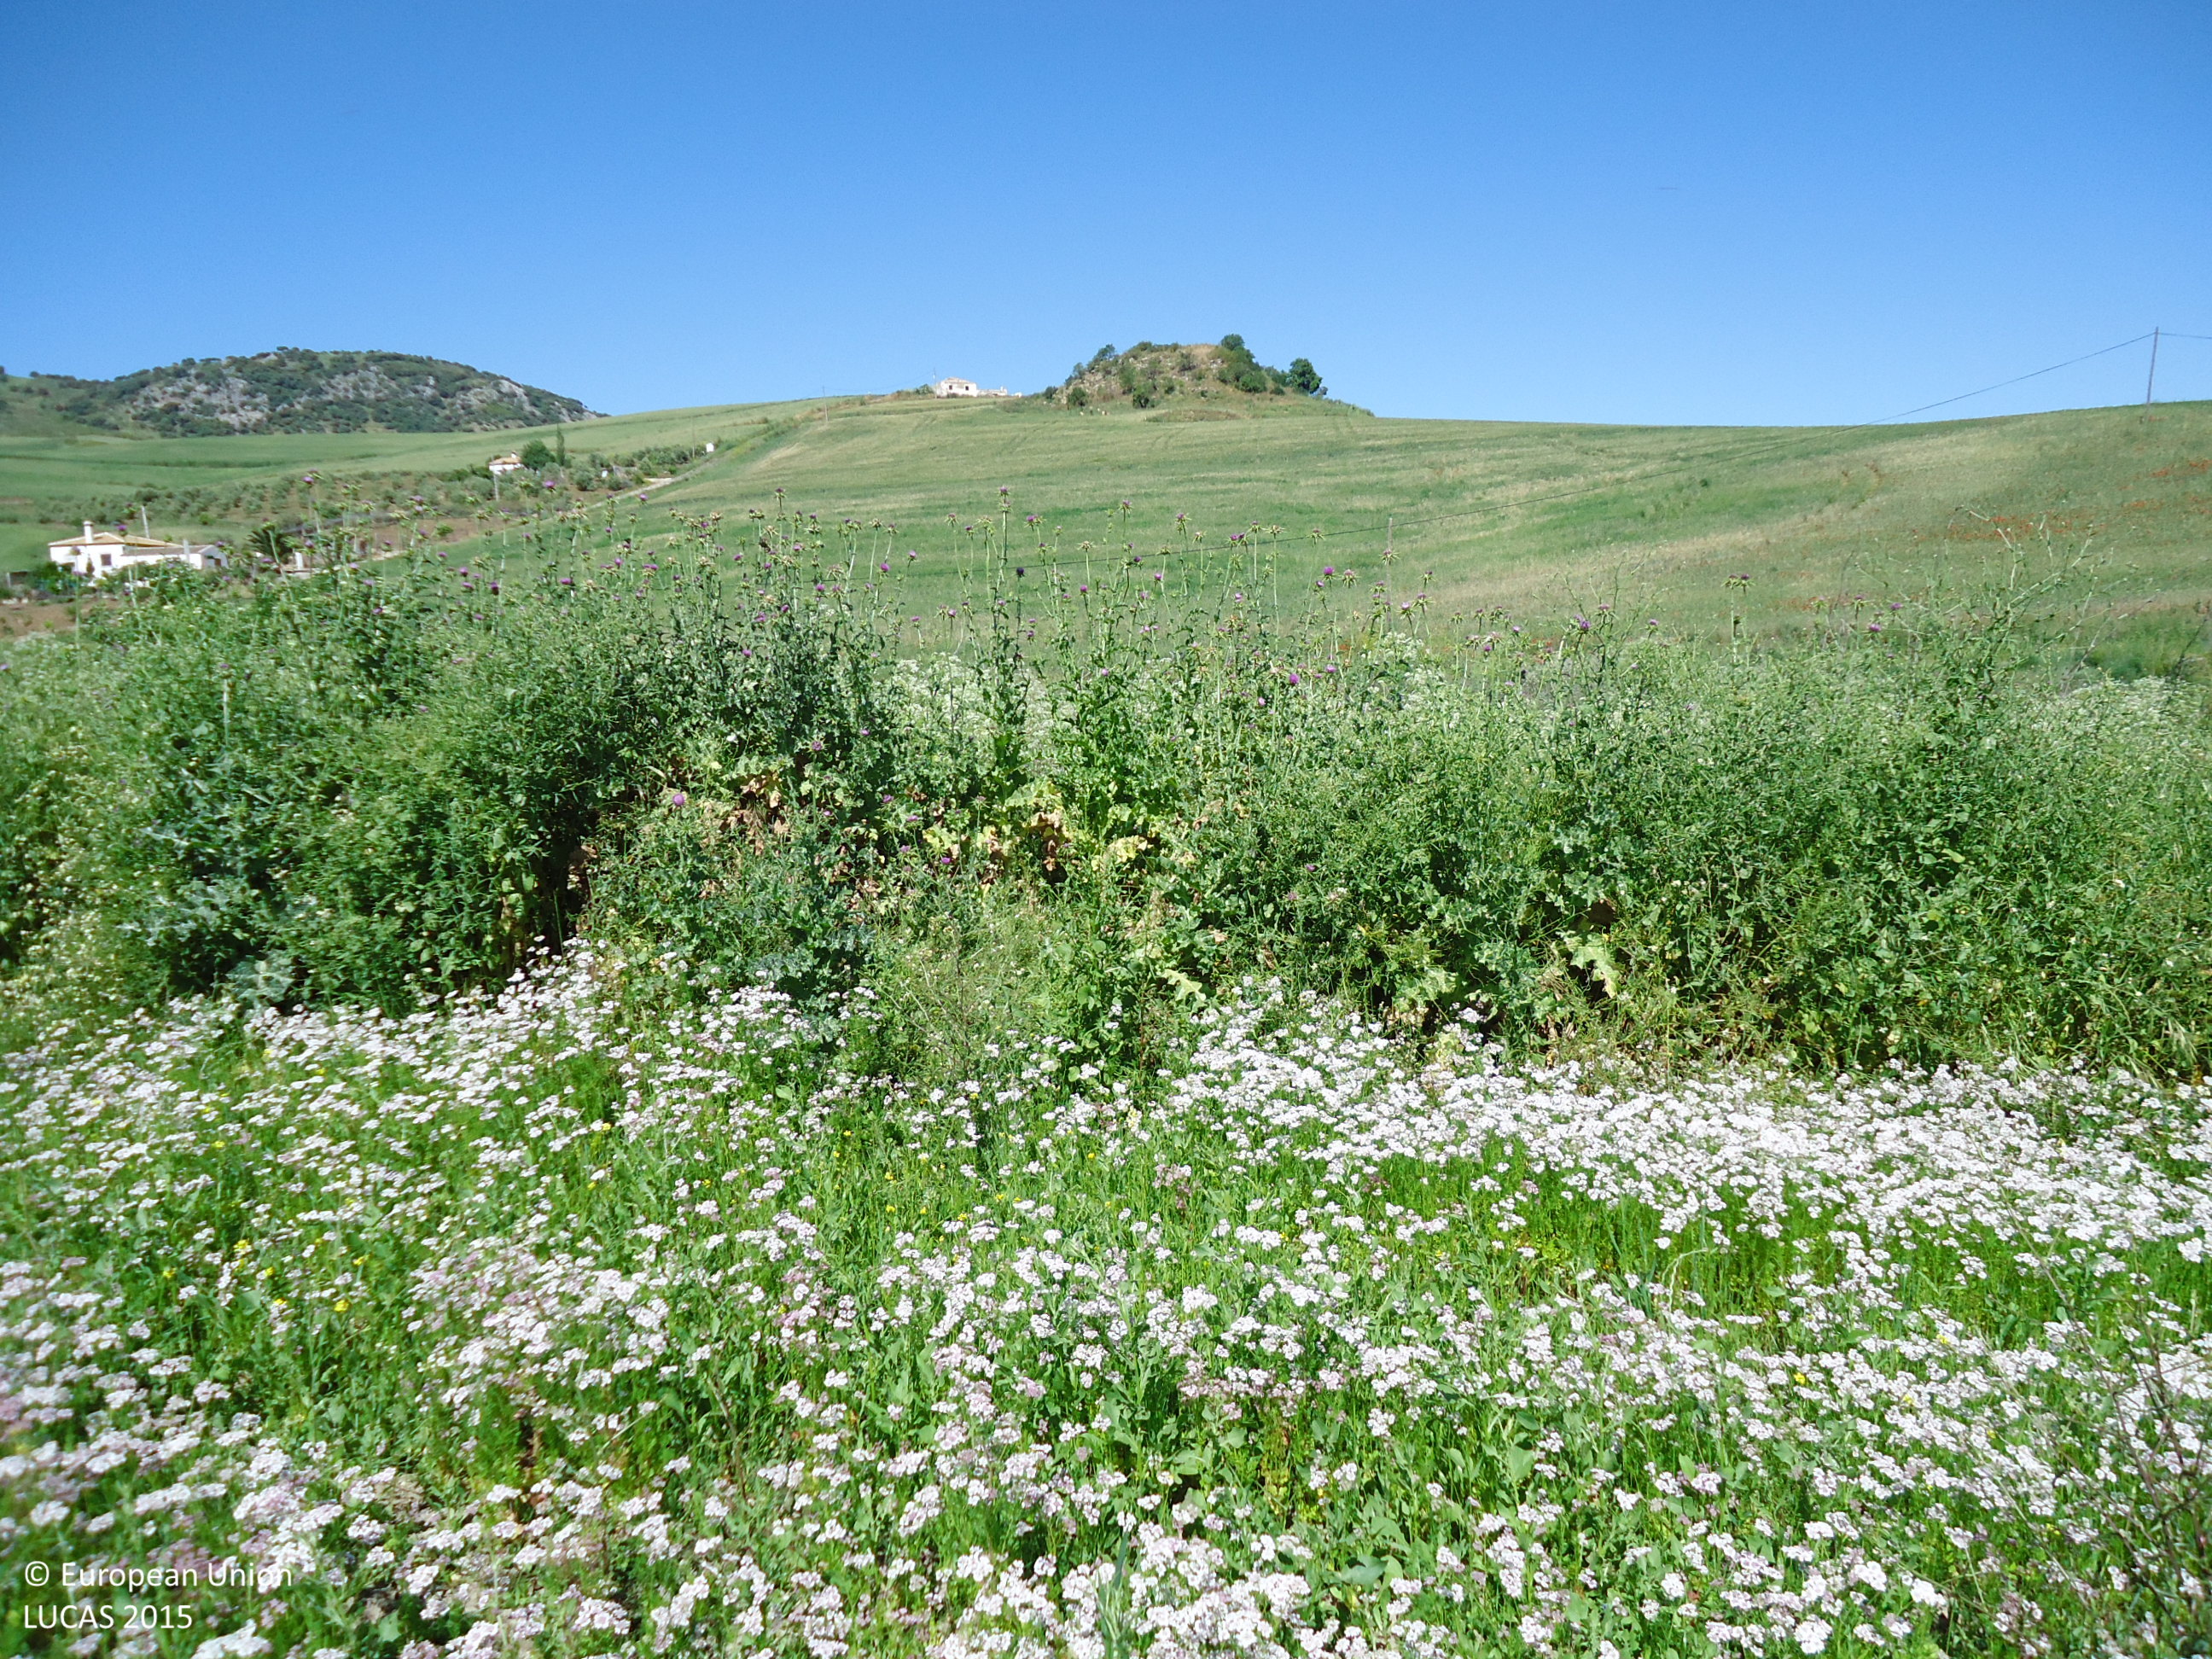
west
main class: Cropland
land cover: Other non-permanent industrial crops
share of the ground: > 75 %
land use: Agriculture (excluding fallow land and kitchen gardens)
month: May
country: ES
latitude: 36.8567
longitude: -5.2677
